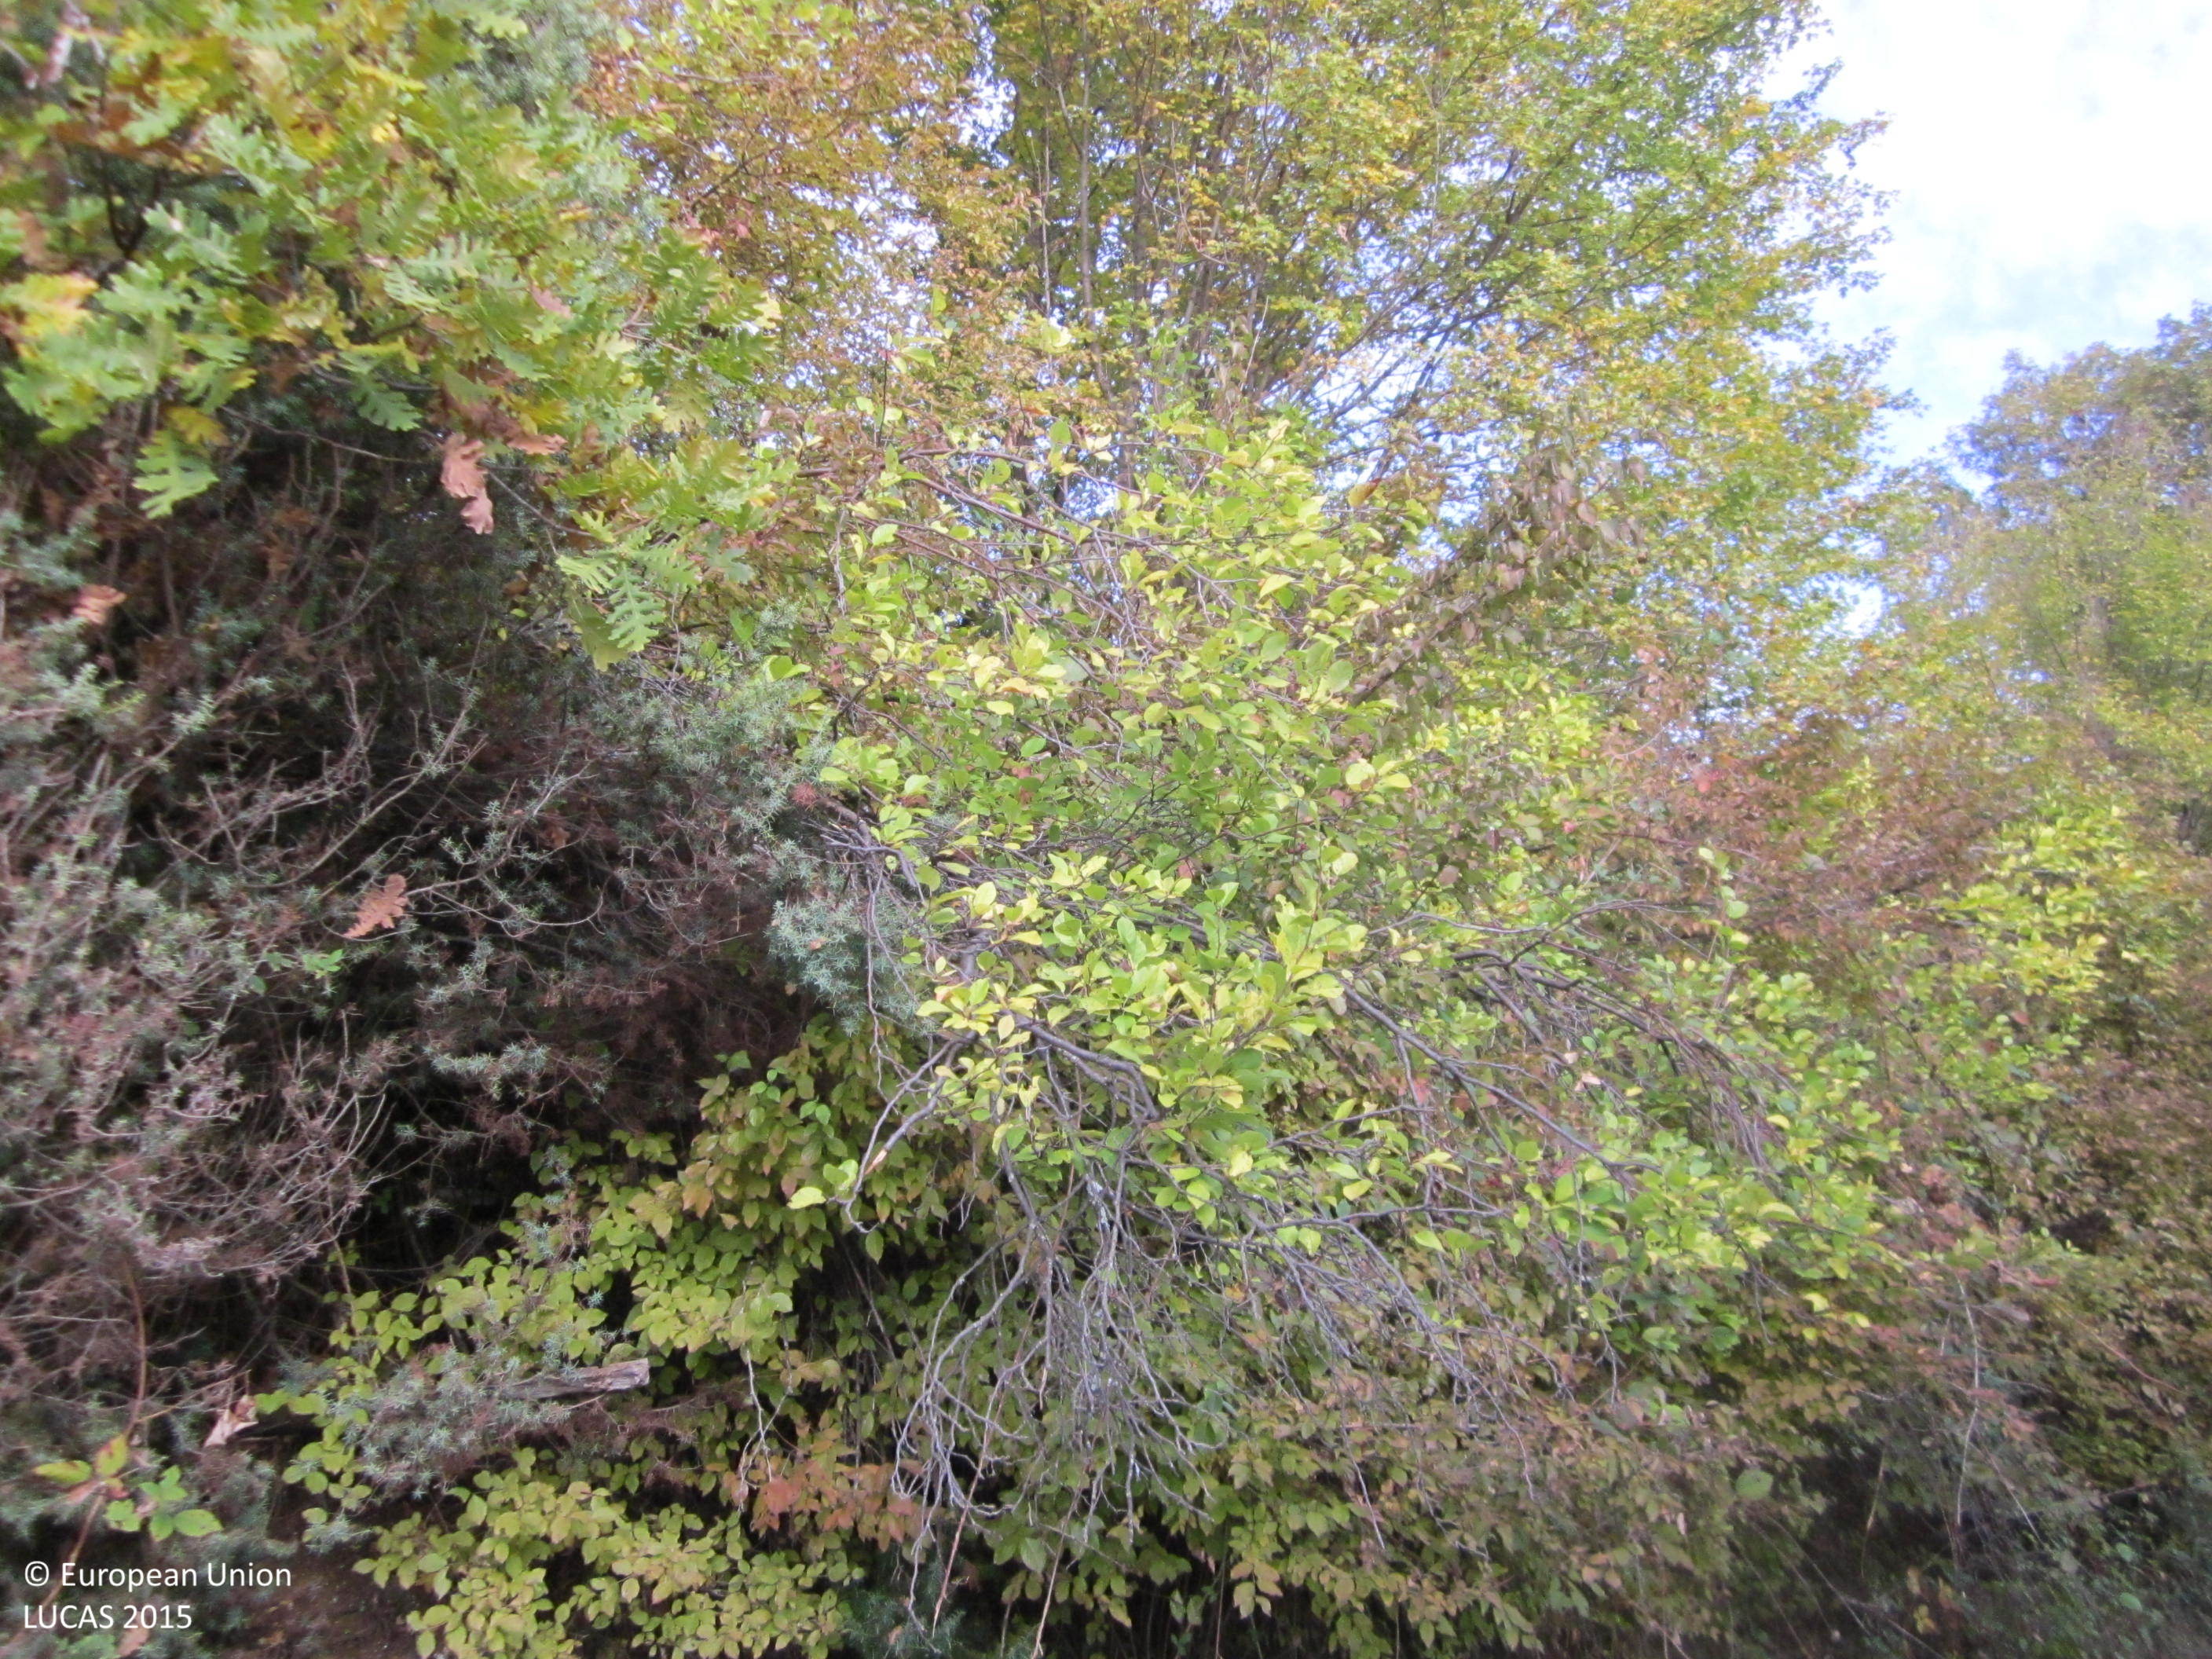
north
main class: Woodland
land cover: Broadleaved woodland
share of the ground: 50 - 75 %
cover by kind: broadleaved forest trees 70 %, shrubs 15 %, herbaceous plants 15 %
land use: Forestry
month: November
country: BG
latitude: 41.3504
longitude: 25.6804
